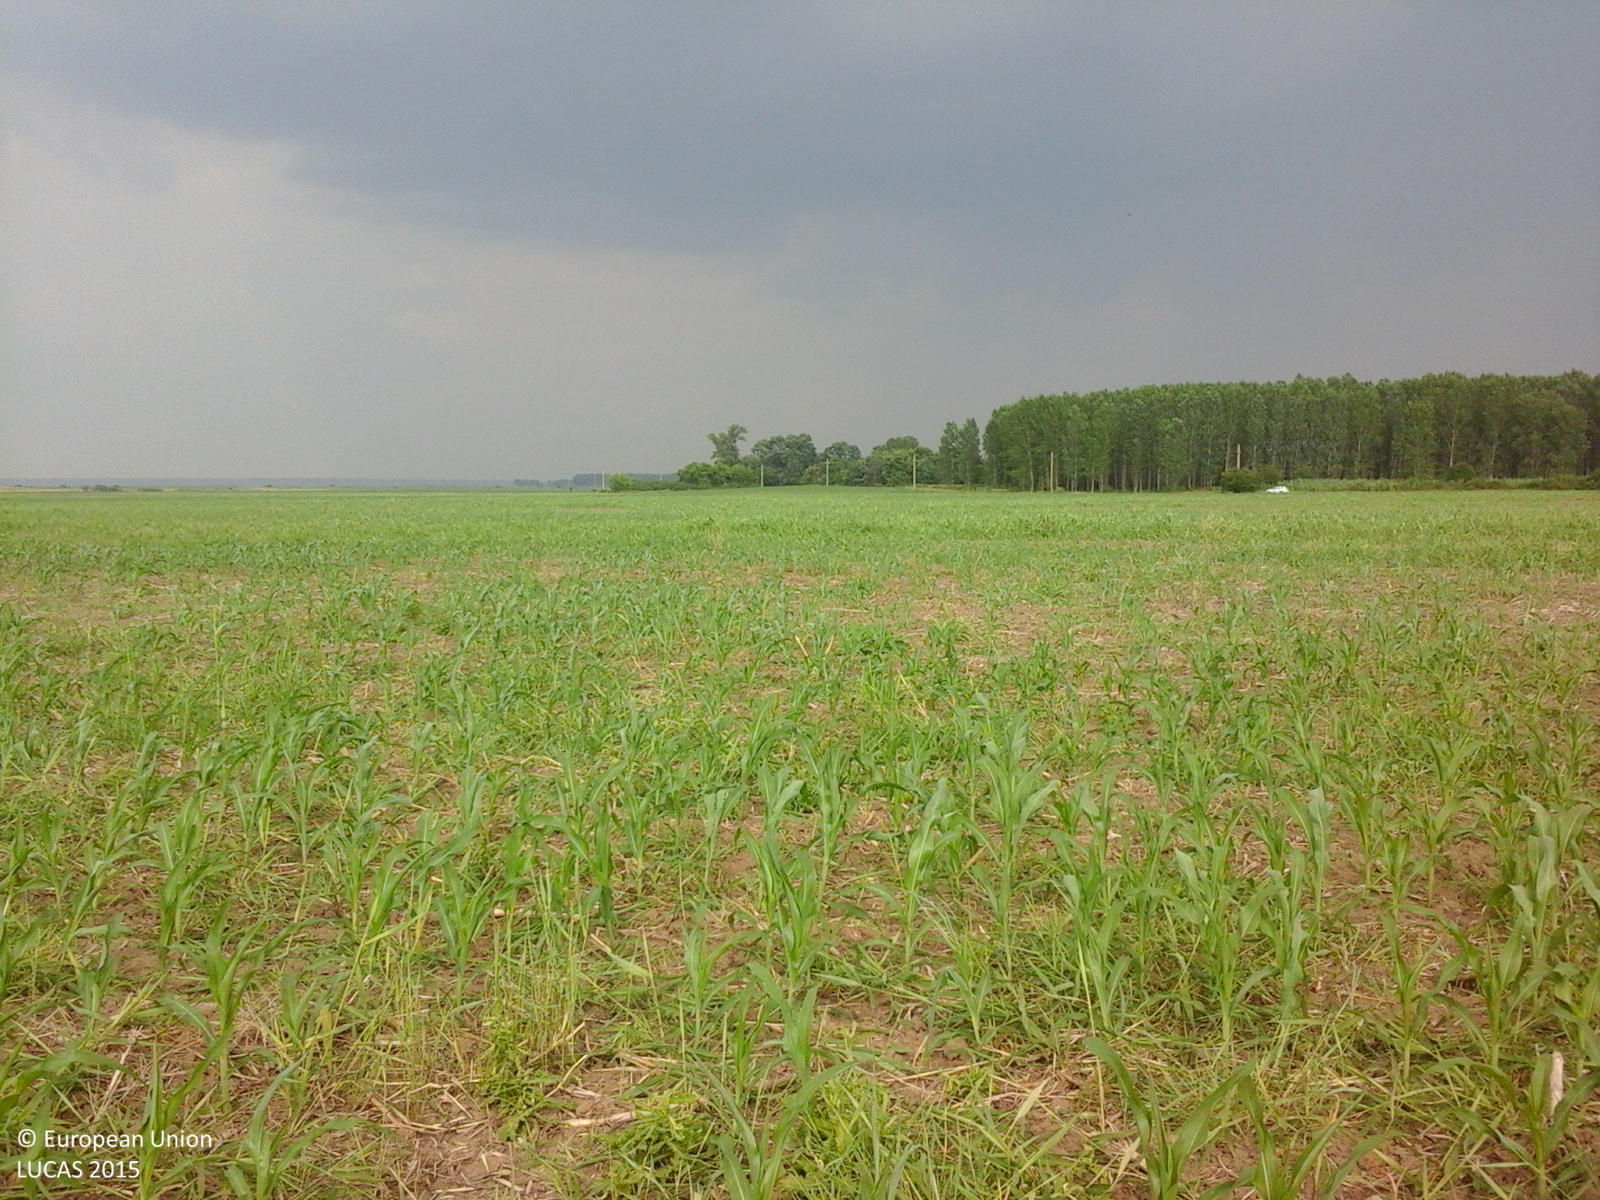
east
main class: Cropland
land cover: Maize
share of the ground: 10 - 25 %
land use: Agriculture (excluding fallow land and kitchen gardens)
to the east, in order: Maize
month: July
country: RO
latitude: 43.6960
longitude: 25.1010
